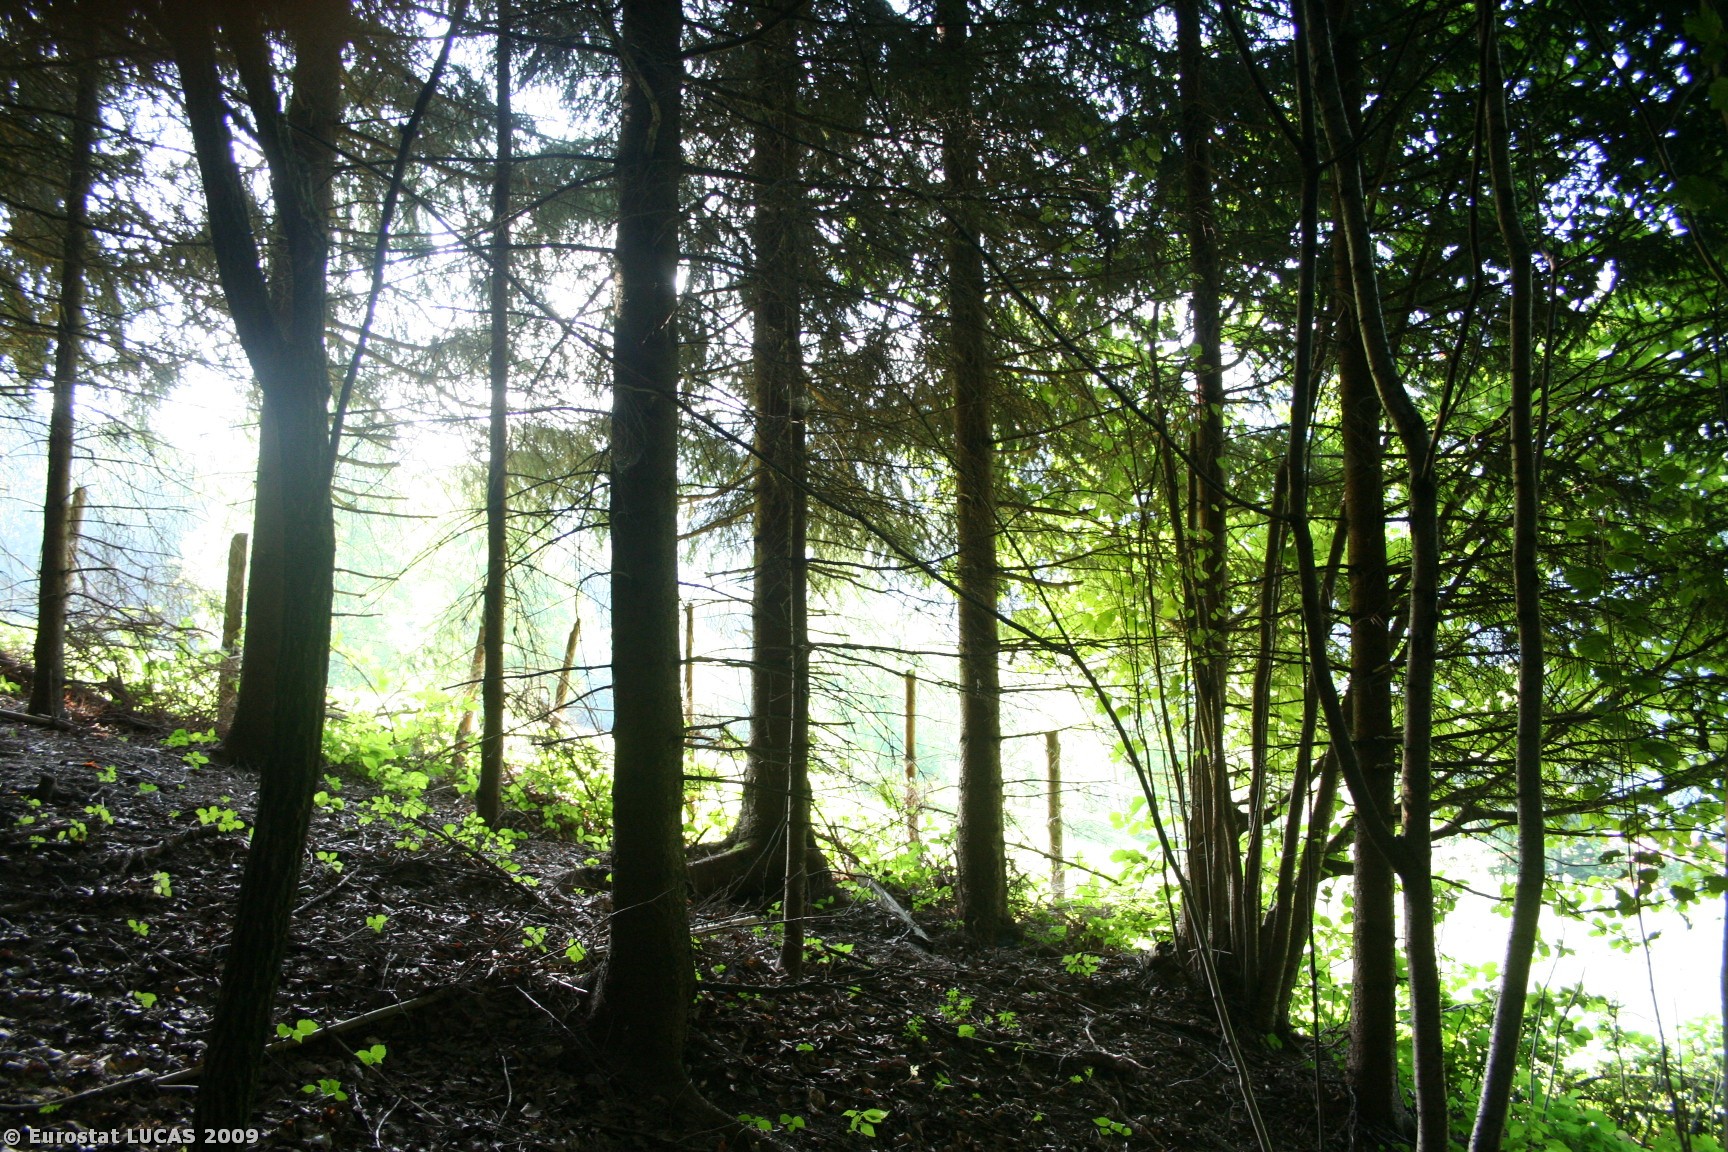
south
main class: Woodland
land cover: Mixed woodland
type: hemiboreal forest and nemoral coniferous forest and mixed broadleaved-coniferous forest
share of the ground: > 75 %
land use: Forestry
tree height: > 5 m
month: August
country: AT
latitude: 47.7085
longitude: 13.2106
